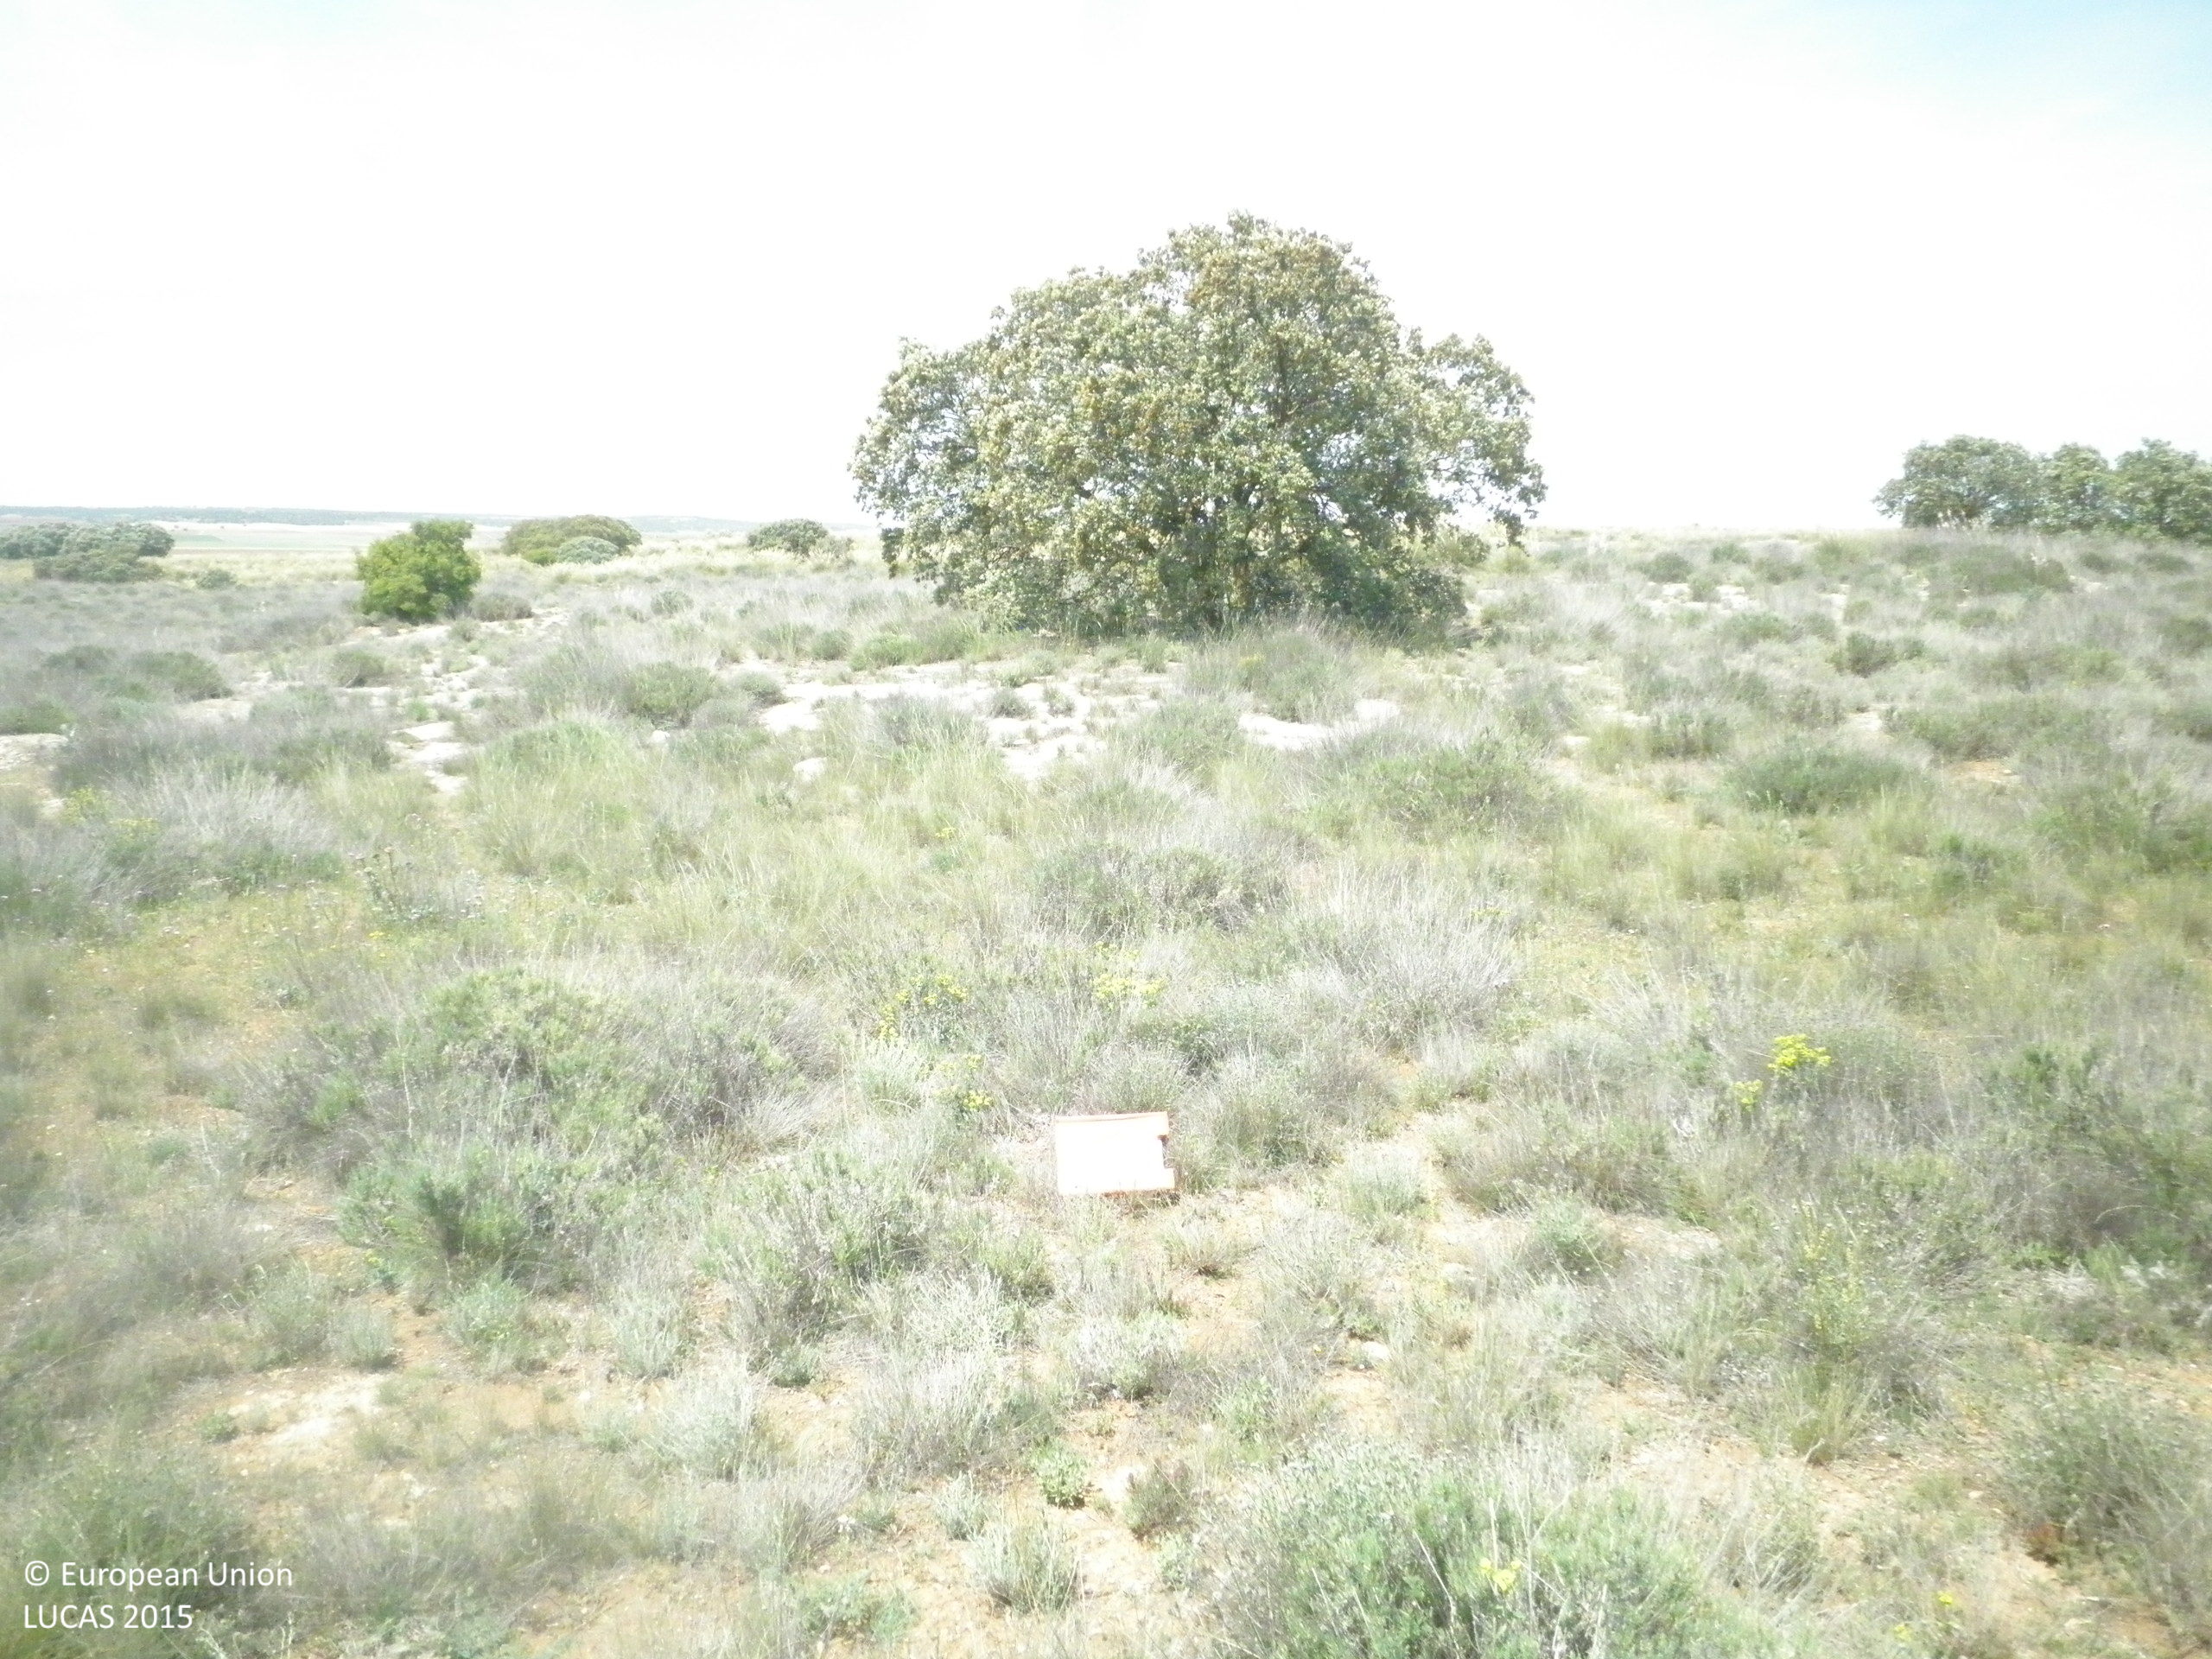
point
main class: Shrubland
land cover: Shrubland without tree cover
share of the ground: 50 - 75 %
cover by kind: unconsolidated bare surface 40 %, shrubs 30 %, herbaceous plants 30 %
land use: Semi-natural and natural areas not in use
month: May
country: ES
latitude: 39.6181
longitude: -2.7245
